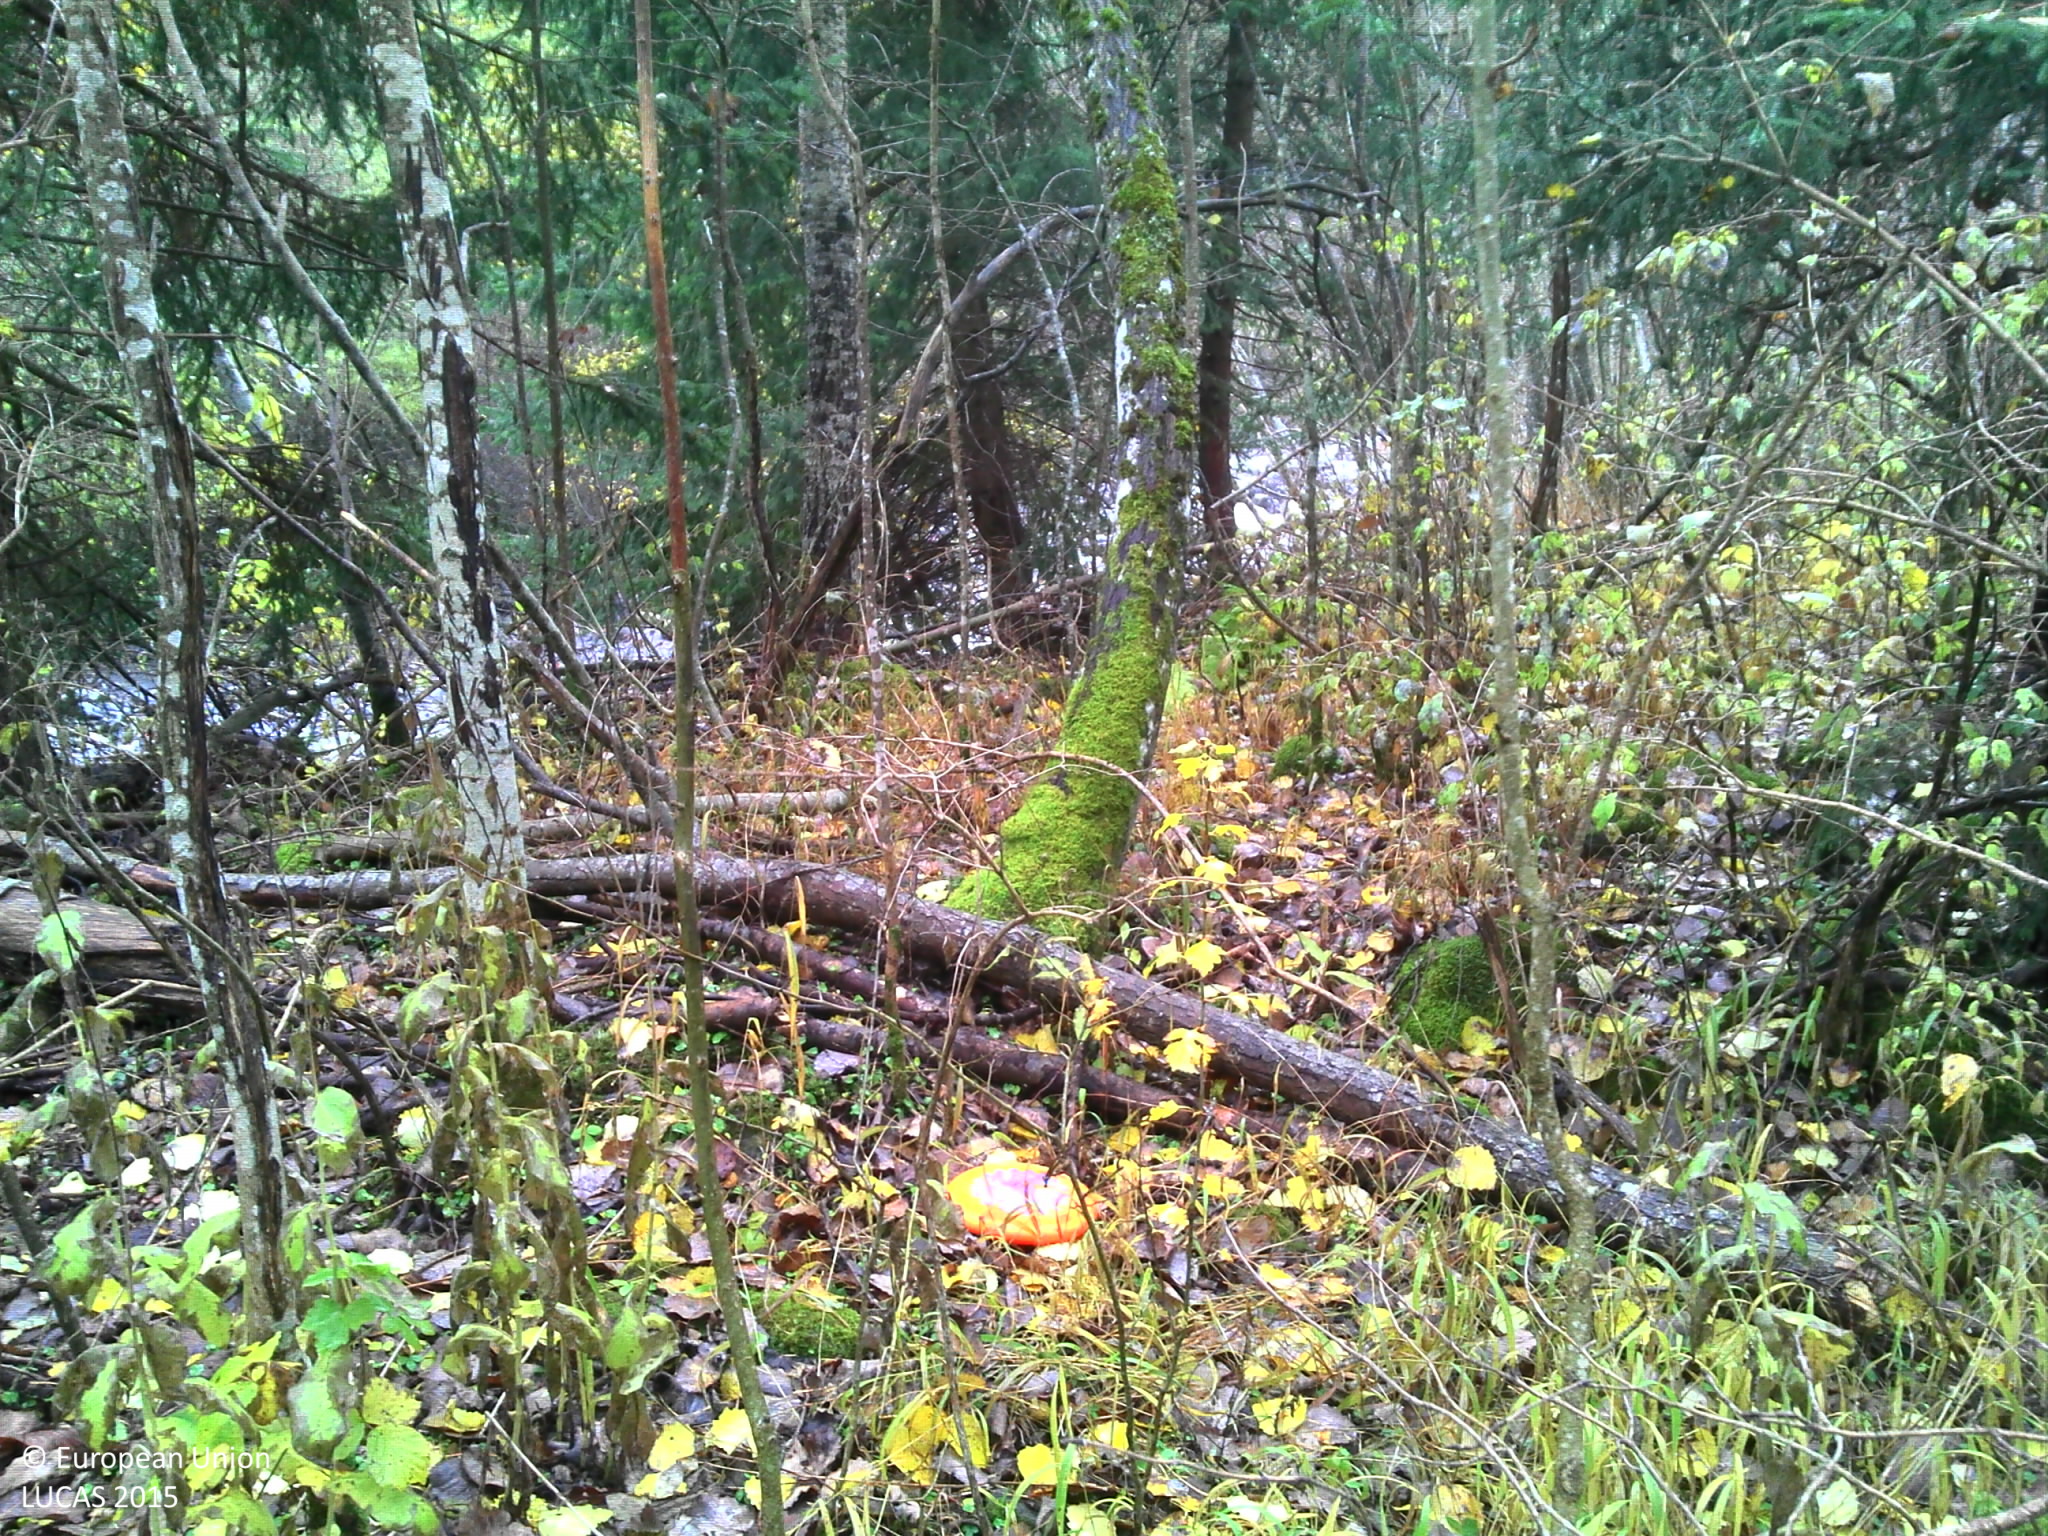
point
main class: Woodland
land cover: Spruce dominated mixed woodland
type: hemiboreal forest and nemoral coniferous forest and mixed broadleaved-coniferous forest
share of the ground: > 75 %
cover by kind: broadleaved forest trees 50 %, coniferous forest trees 30 %, shrubs 10 %, lichens and mosses 5 %, consolidated bare surface 5 %
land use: Forestry
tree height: > 5 m
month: October
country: FR
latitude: 45.3920
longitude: 6.4921
